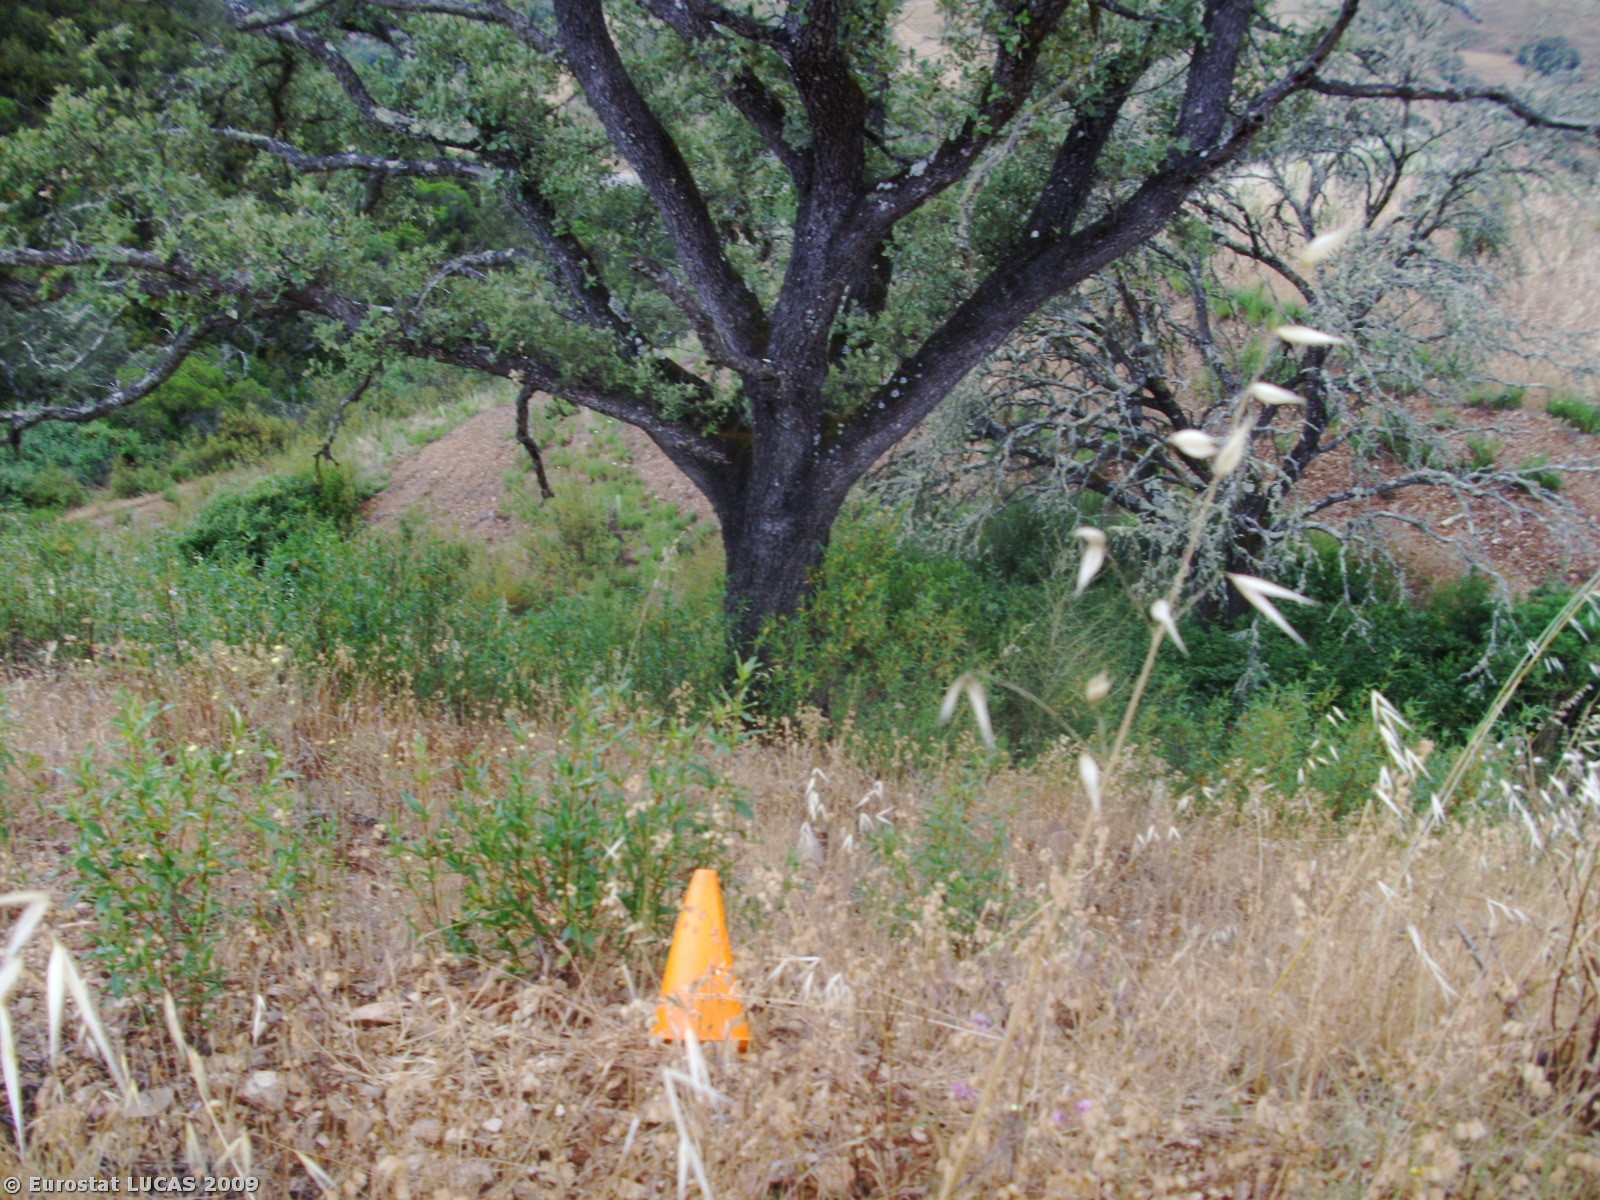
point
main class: Woodland
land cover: Broadleaved woodland
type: broadleaved evergreen forest
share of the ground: 10 - 25 %
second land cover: Spontaneously vegetated surfaces
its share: 50 - 75 %
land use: Forestry
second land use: Fallow land
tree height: > 5 m
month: June
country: PT
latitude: 37.4595
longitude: -8.4700
